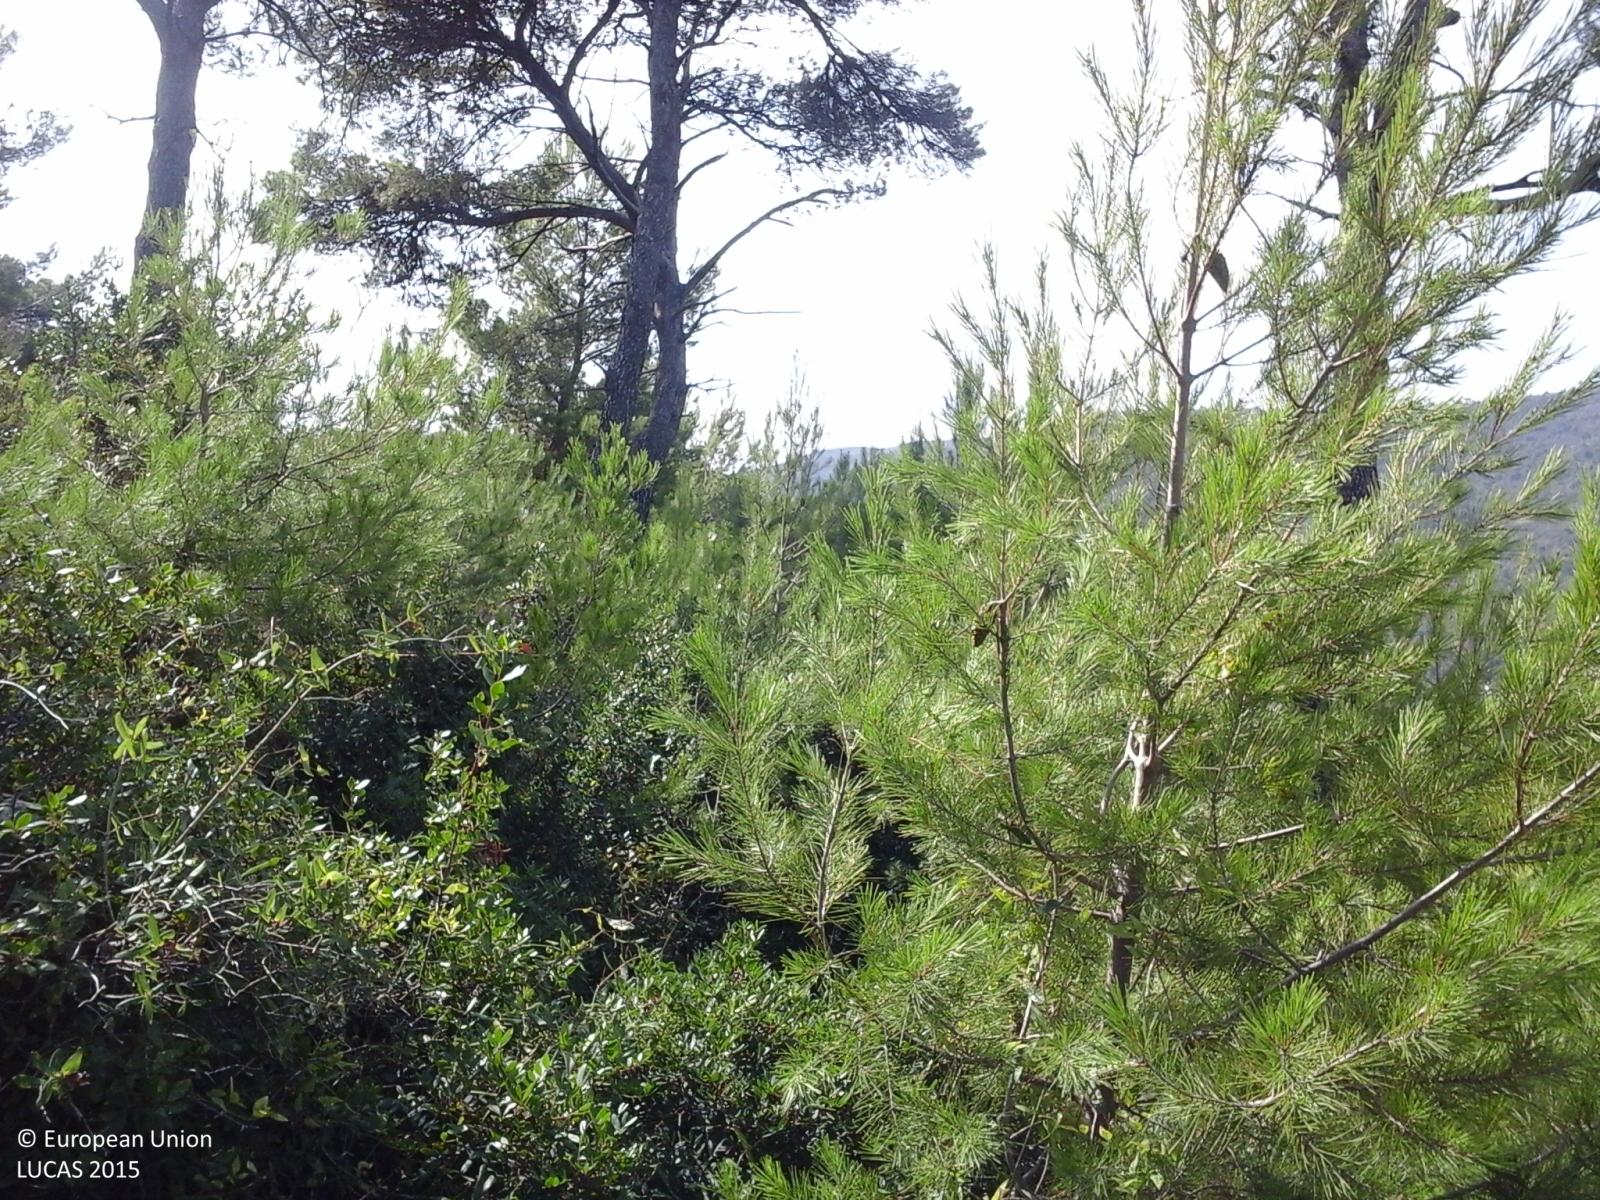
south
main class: Woodland
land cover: Pine dominated coniferous woodland
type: coniferous forest of the mediterranean region
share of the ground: > 75 %
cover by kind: coniferous forest trees 70 %, shrubs 20 %, broadleaved forest trees 5 %, herbaceous plants 5 %
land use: Forestry
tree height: > 5 m
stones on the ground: > 50 %
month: October
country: IT
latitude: 43.9732
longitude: 8.1472
